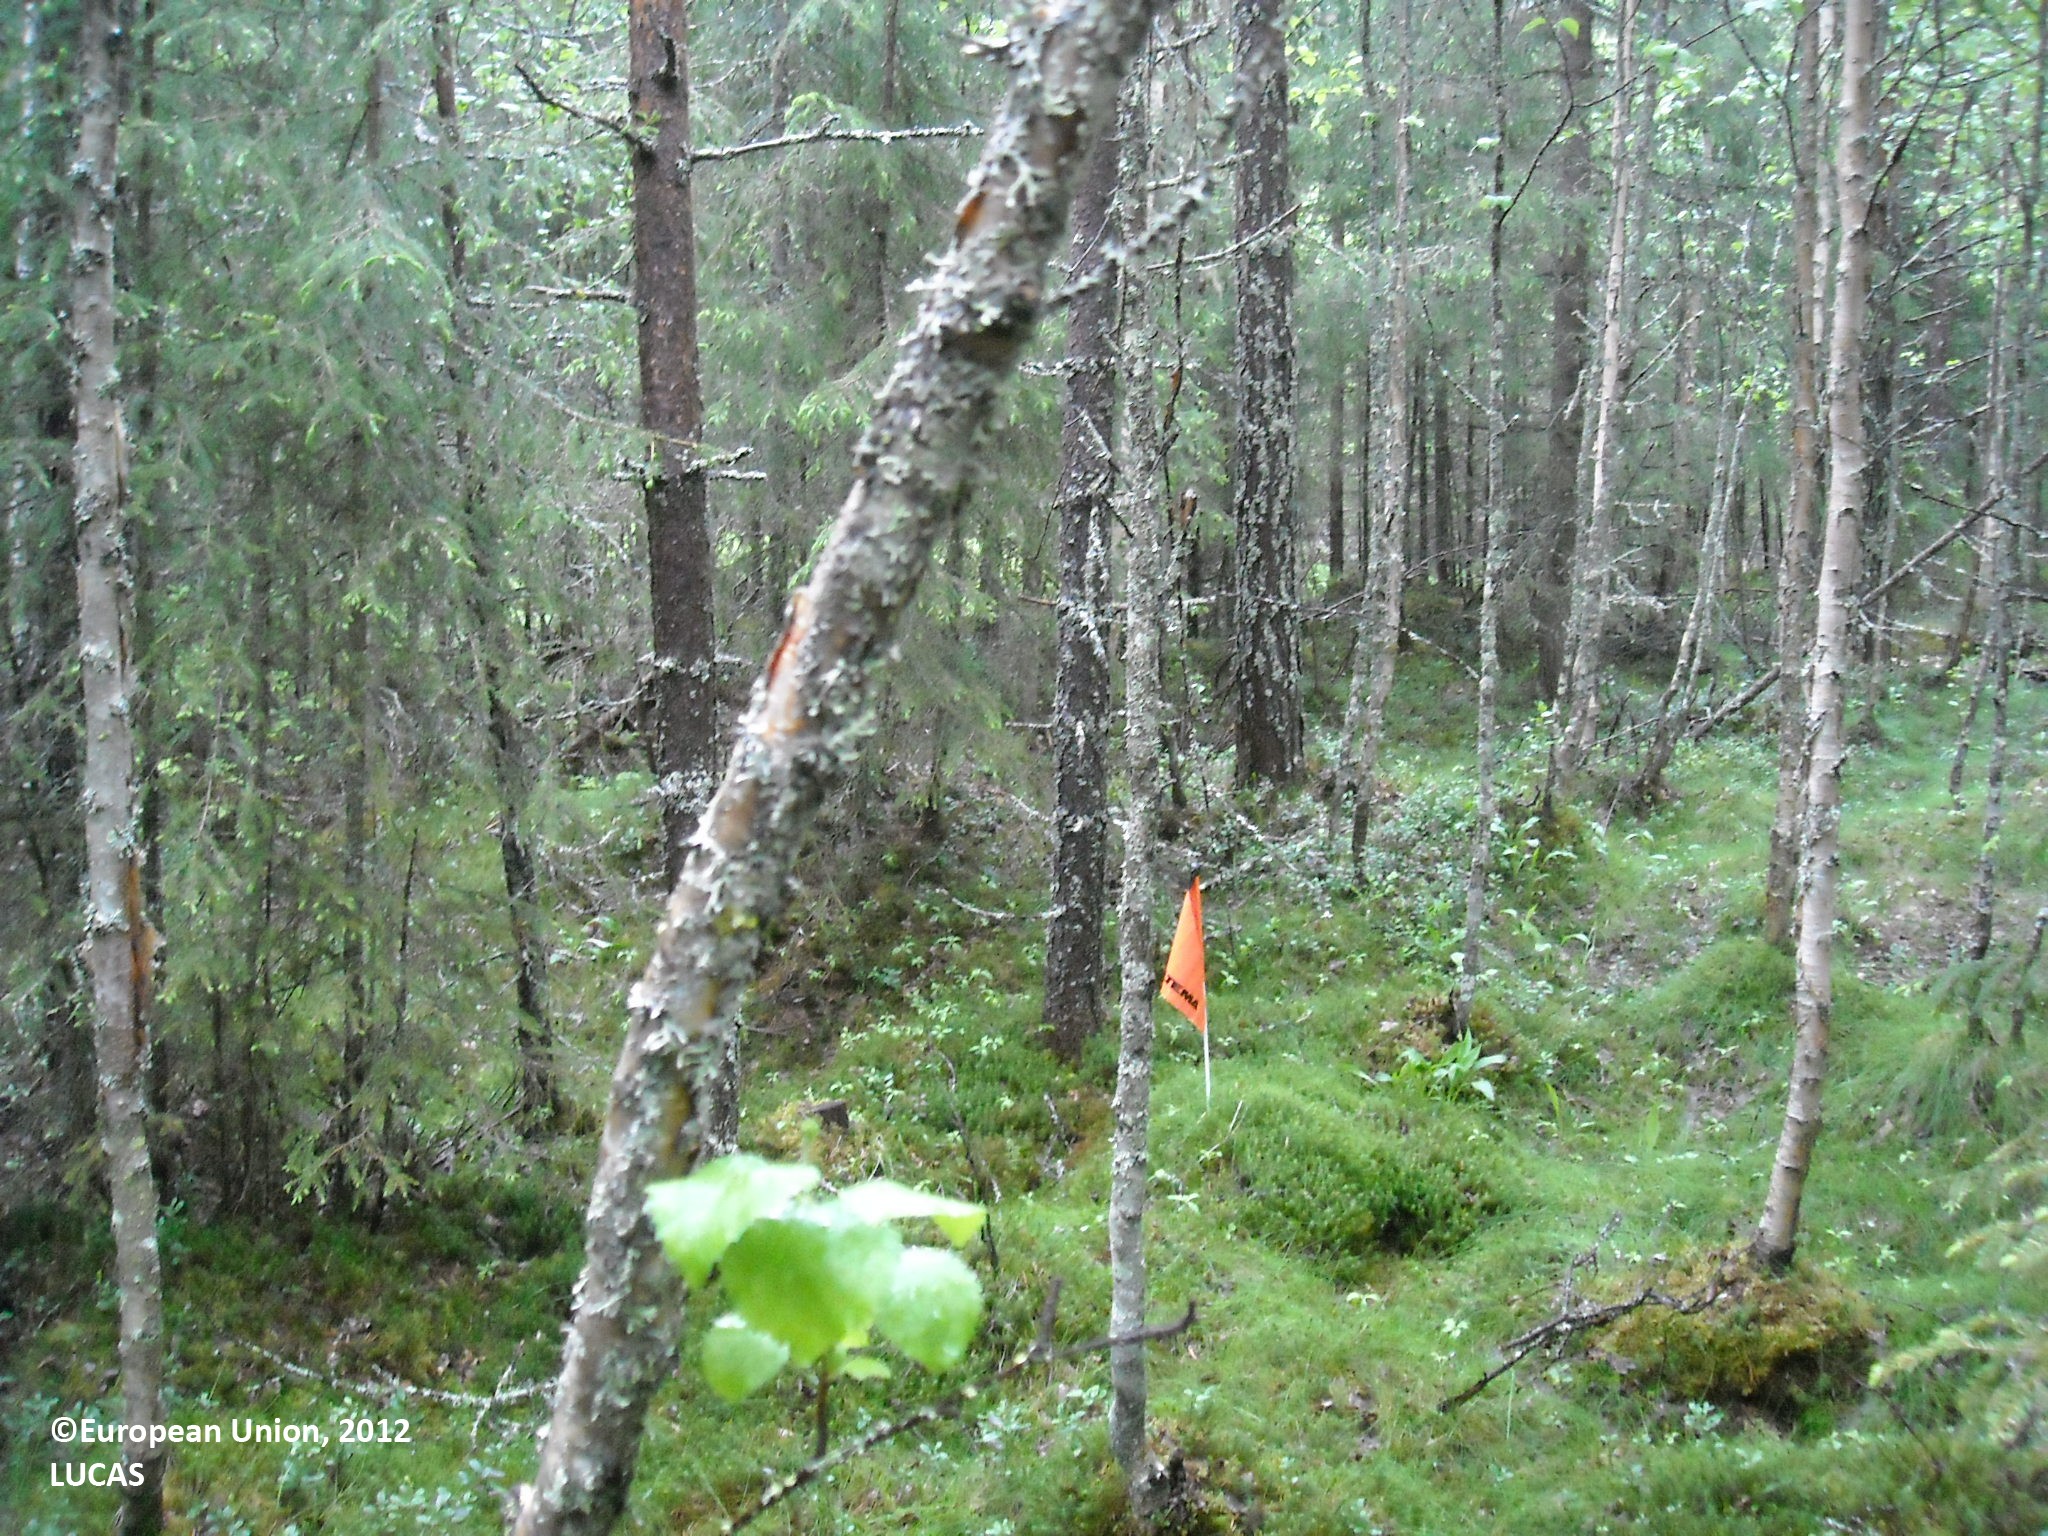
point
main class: Woodland
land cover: Other mixed woodland
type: boreal forest
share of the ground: > 75 %
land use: Forestry
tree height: > 5 m
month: June
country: FI
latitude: 65.4728
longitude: 27.9100
